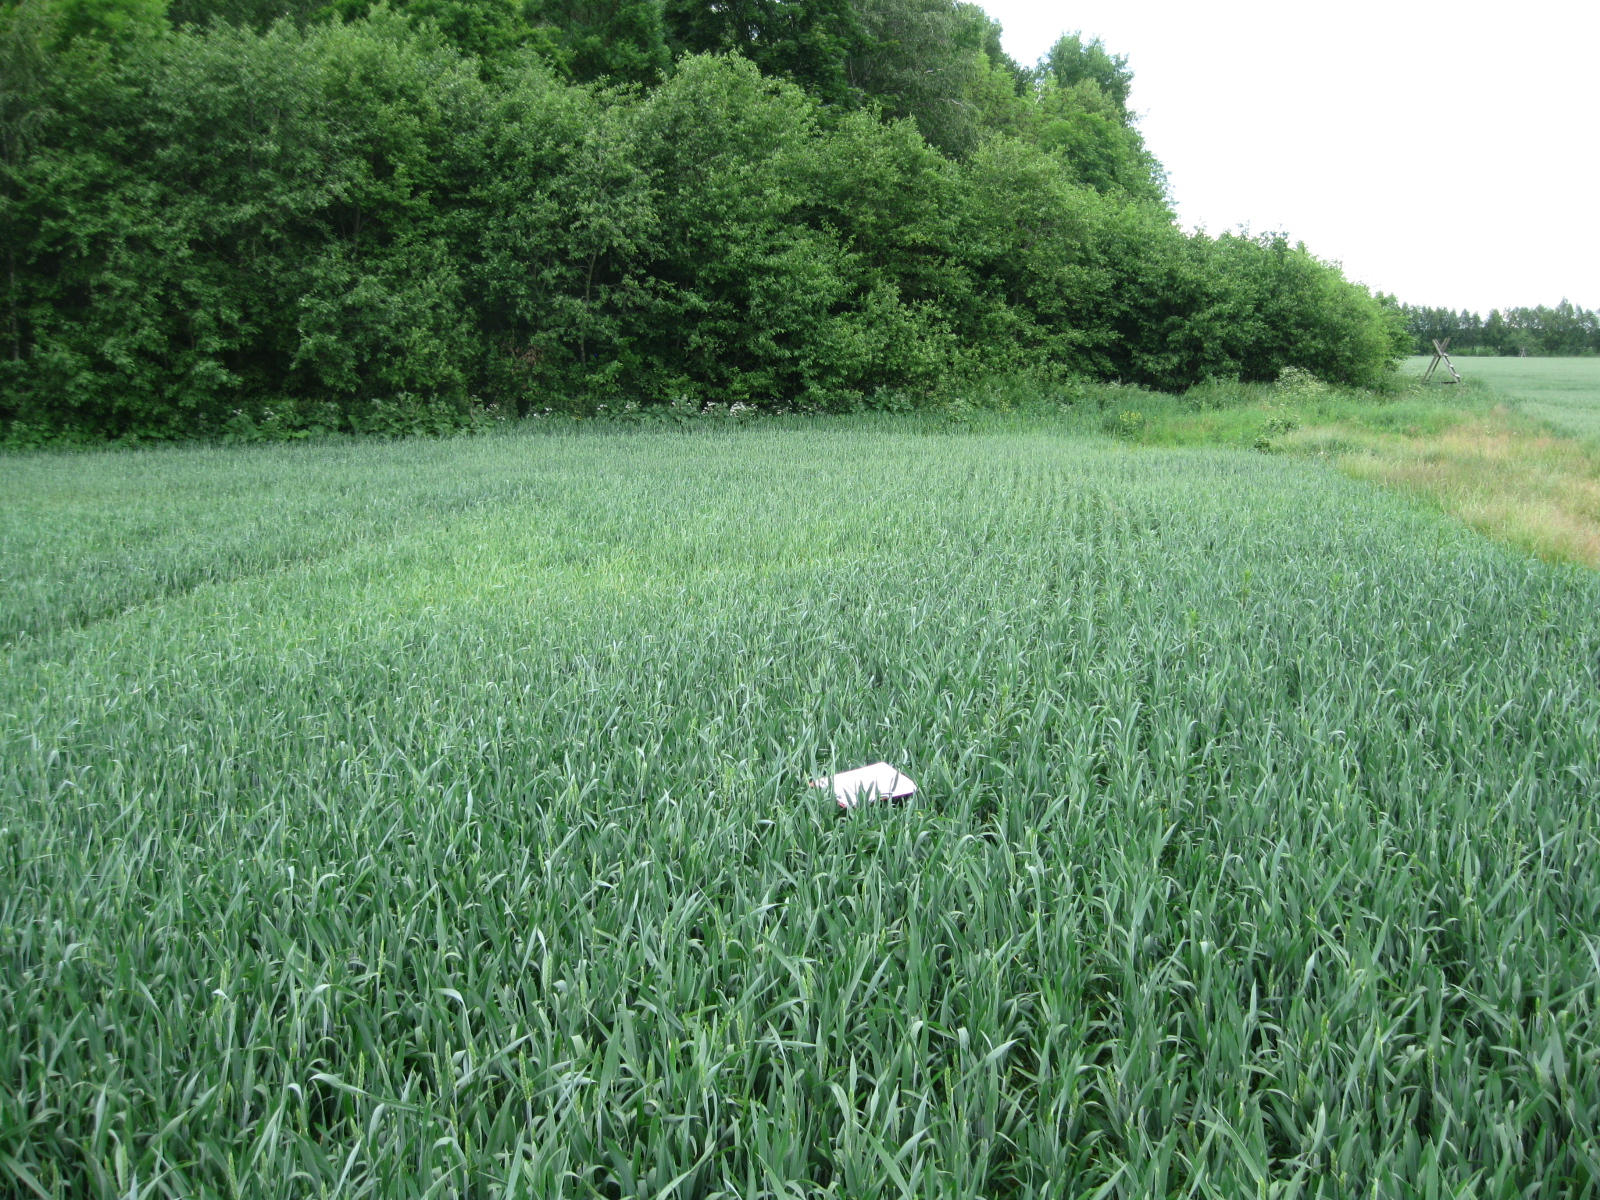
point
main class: Cropland
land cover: Common wheat
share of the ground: > 75 %
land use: Agriculture (excluding fallow land and kitchen gardens)
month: June
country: LT
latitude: 55.3090
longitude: 24.1298
